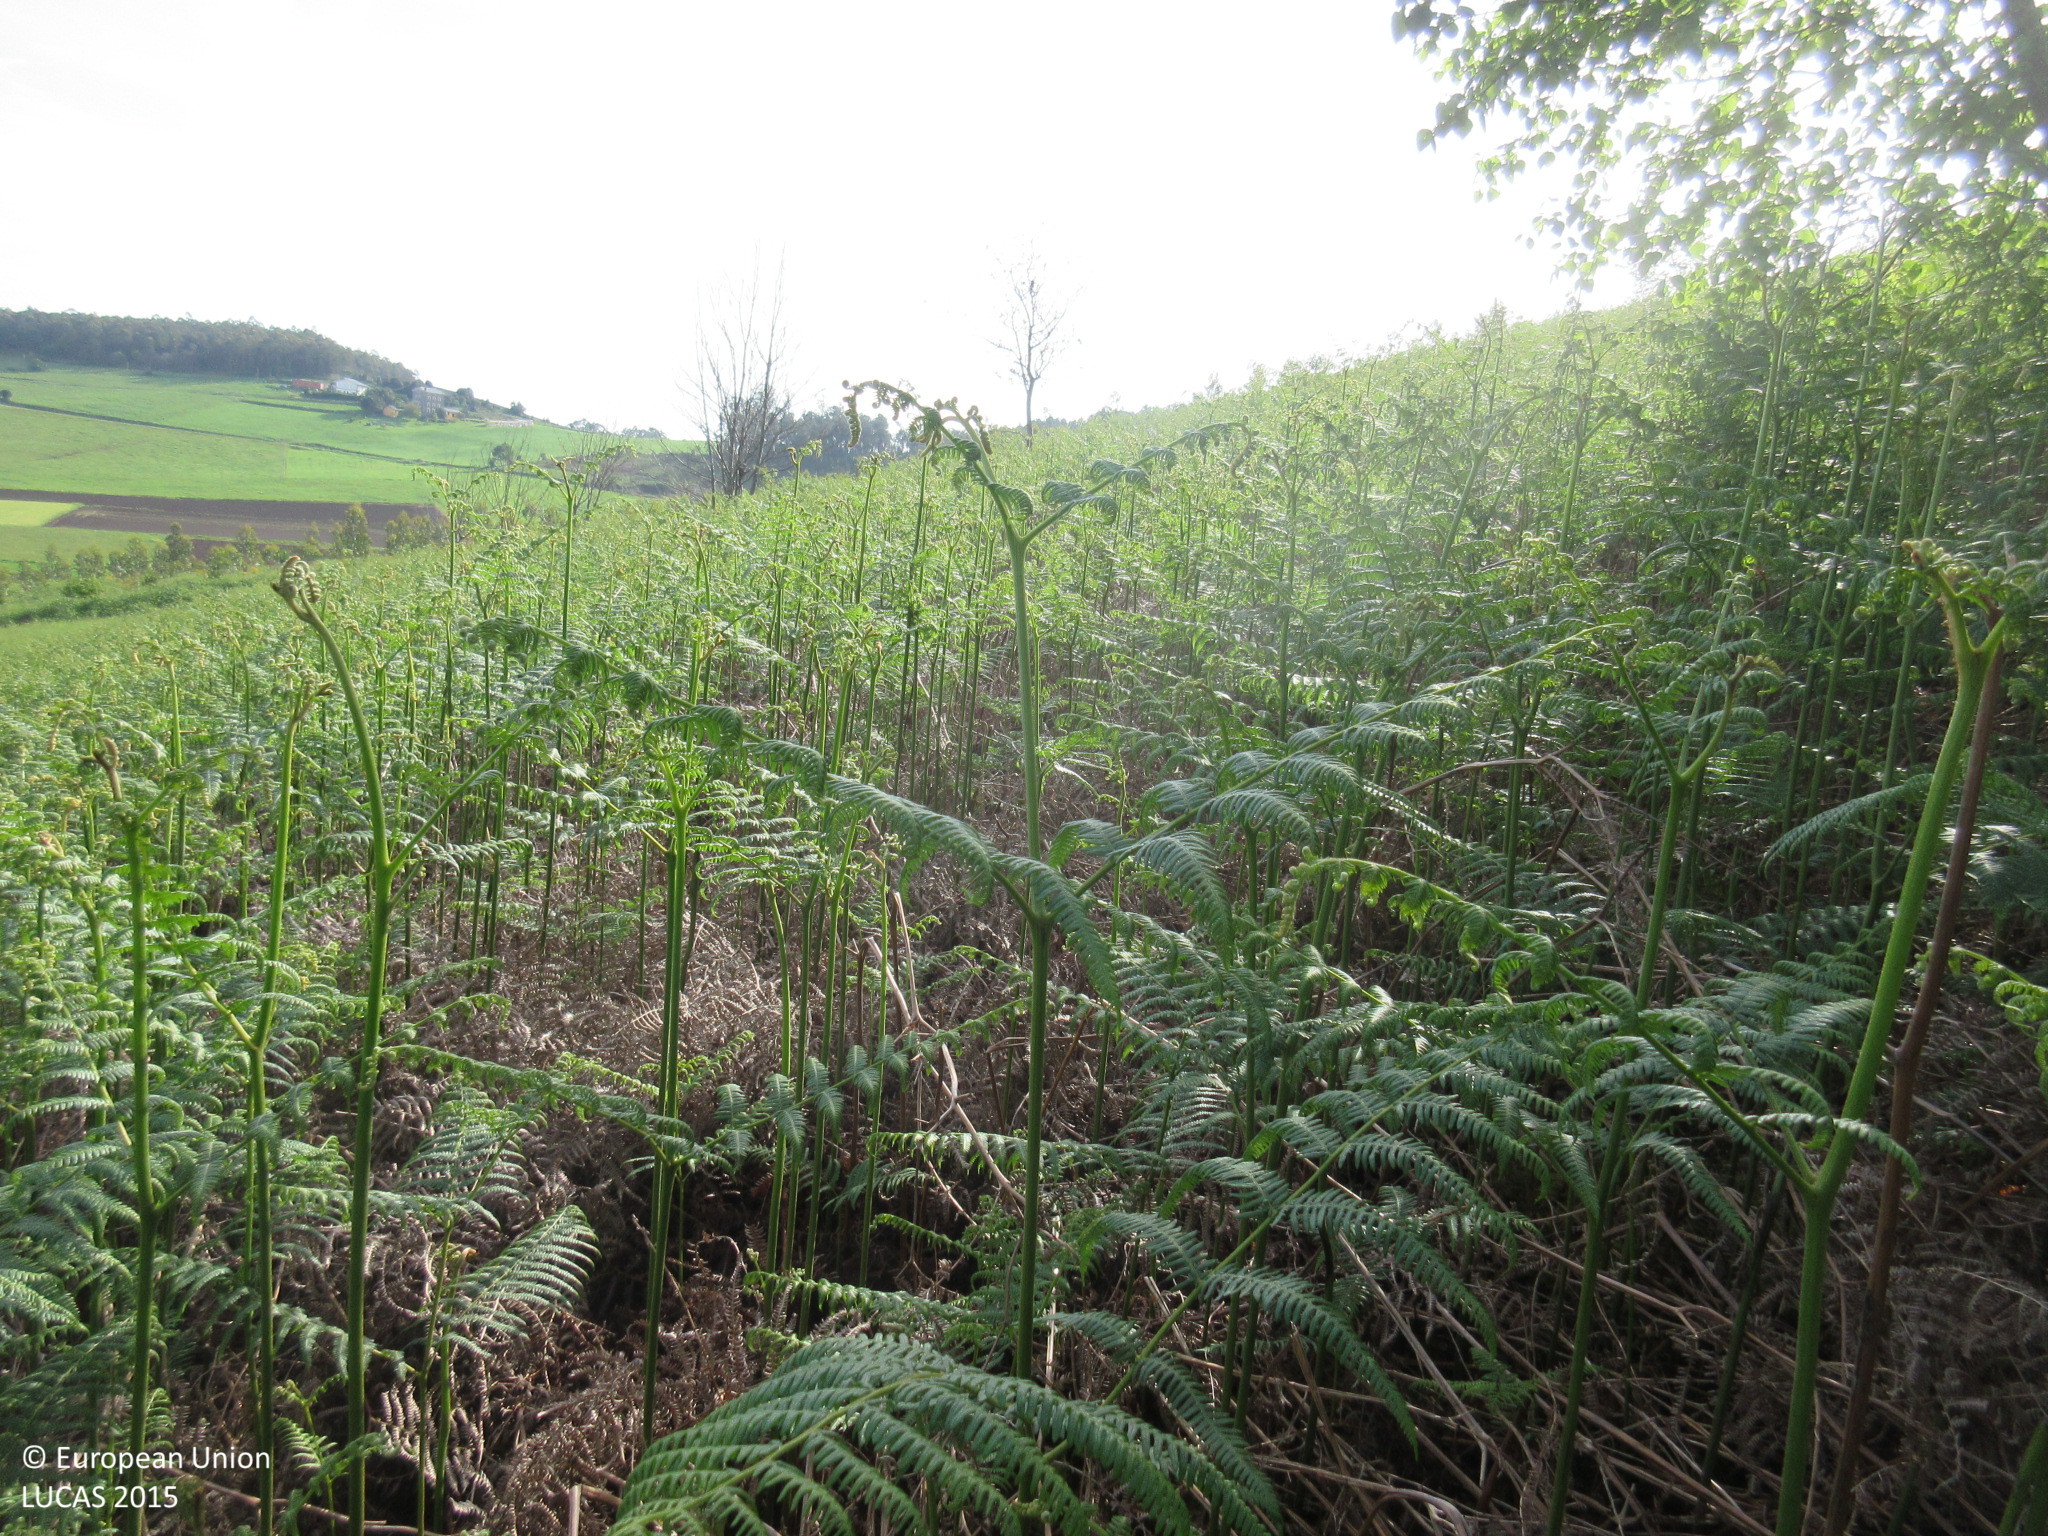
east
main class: Shrubland
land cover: Shrubland without tree cover
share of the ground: > 75 %
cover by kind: shrubs 100 %
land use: Semi-natural and natural areas not in use
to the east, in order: Shrubland without tree cover; Shrubland with sparse tree cover; Shrubland without tree cover
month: April
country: ES
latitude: 43.5189
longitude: -6.6998
